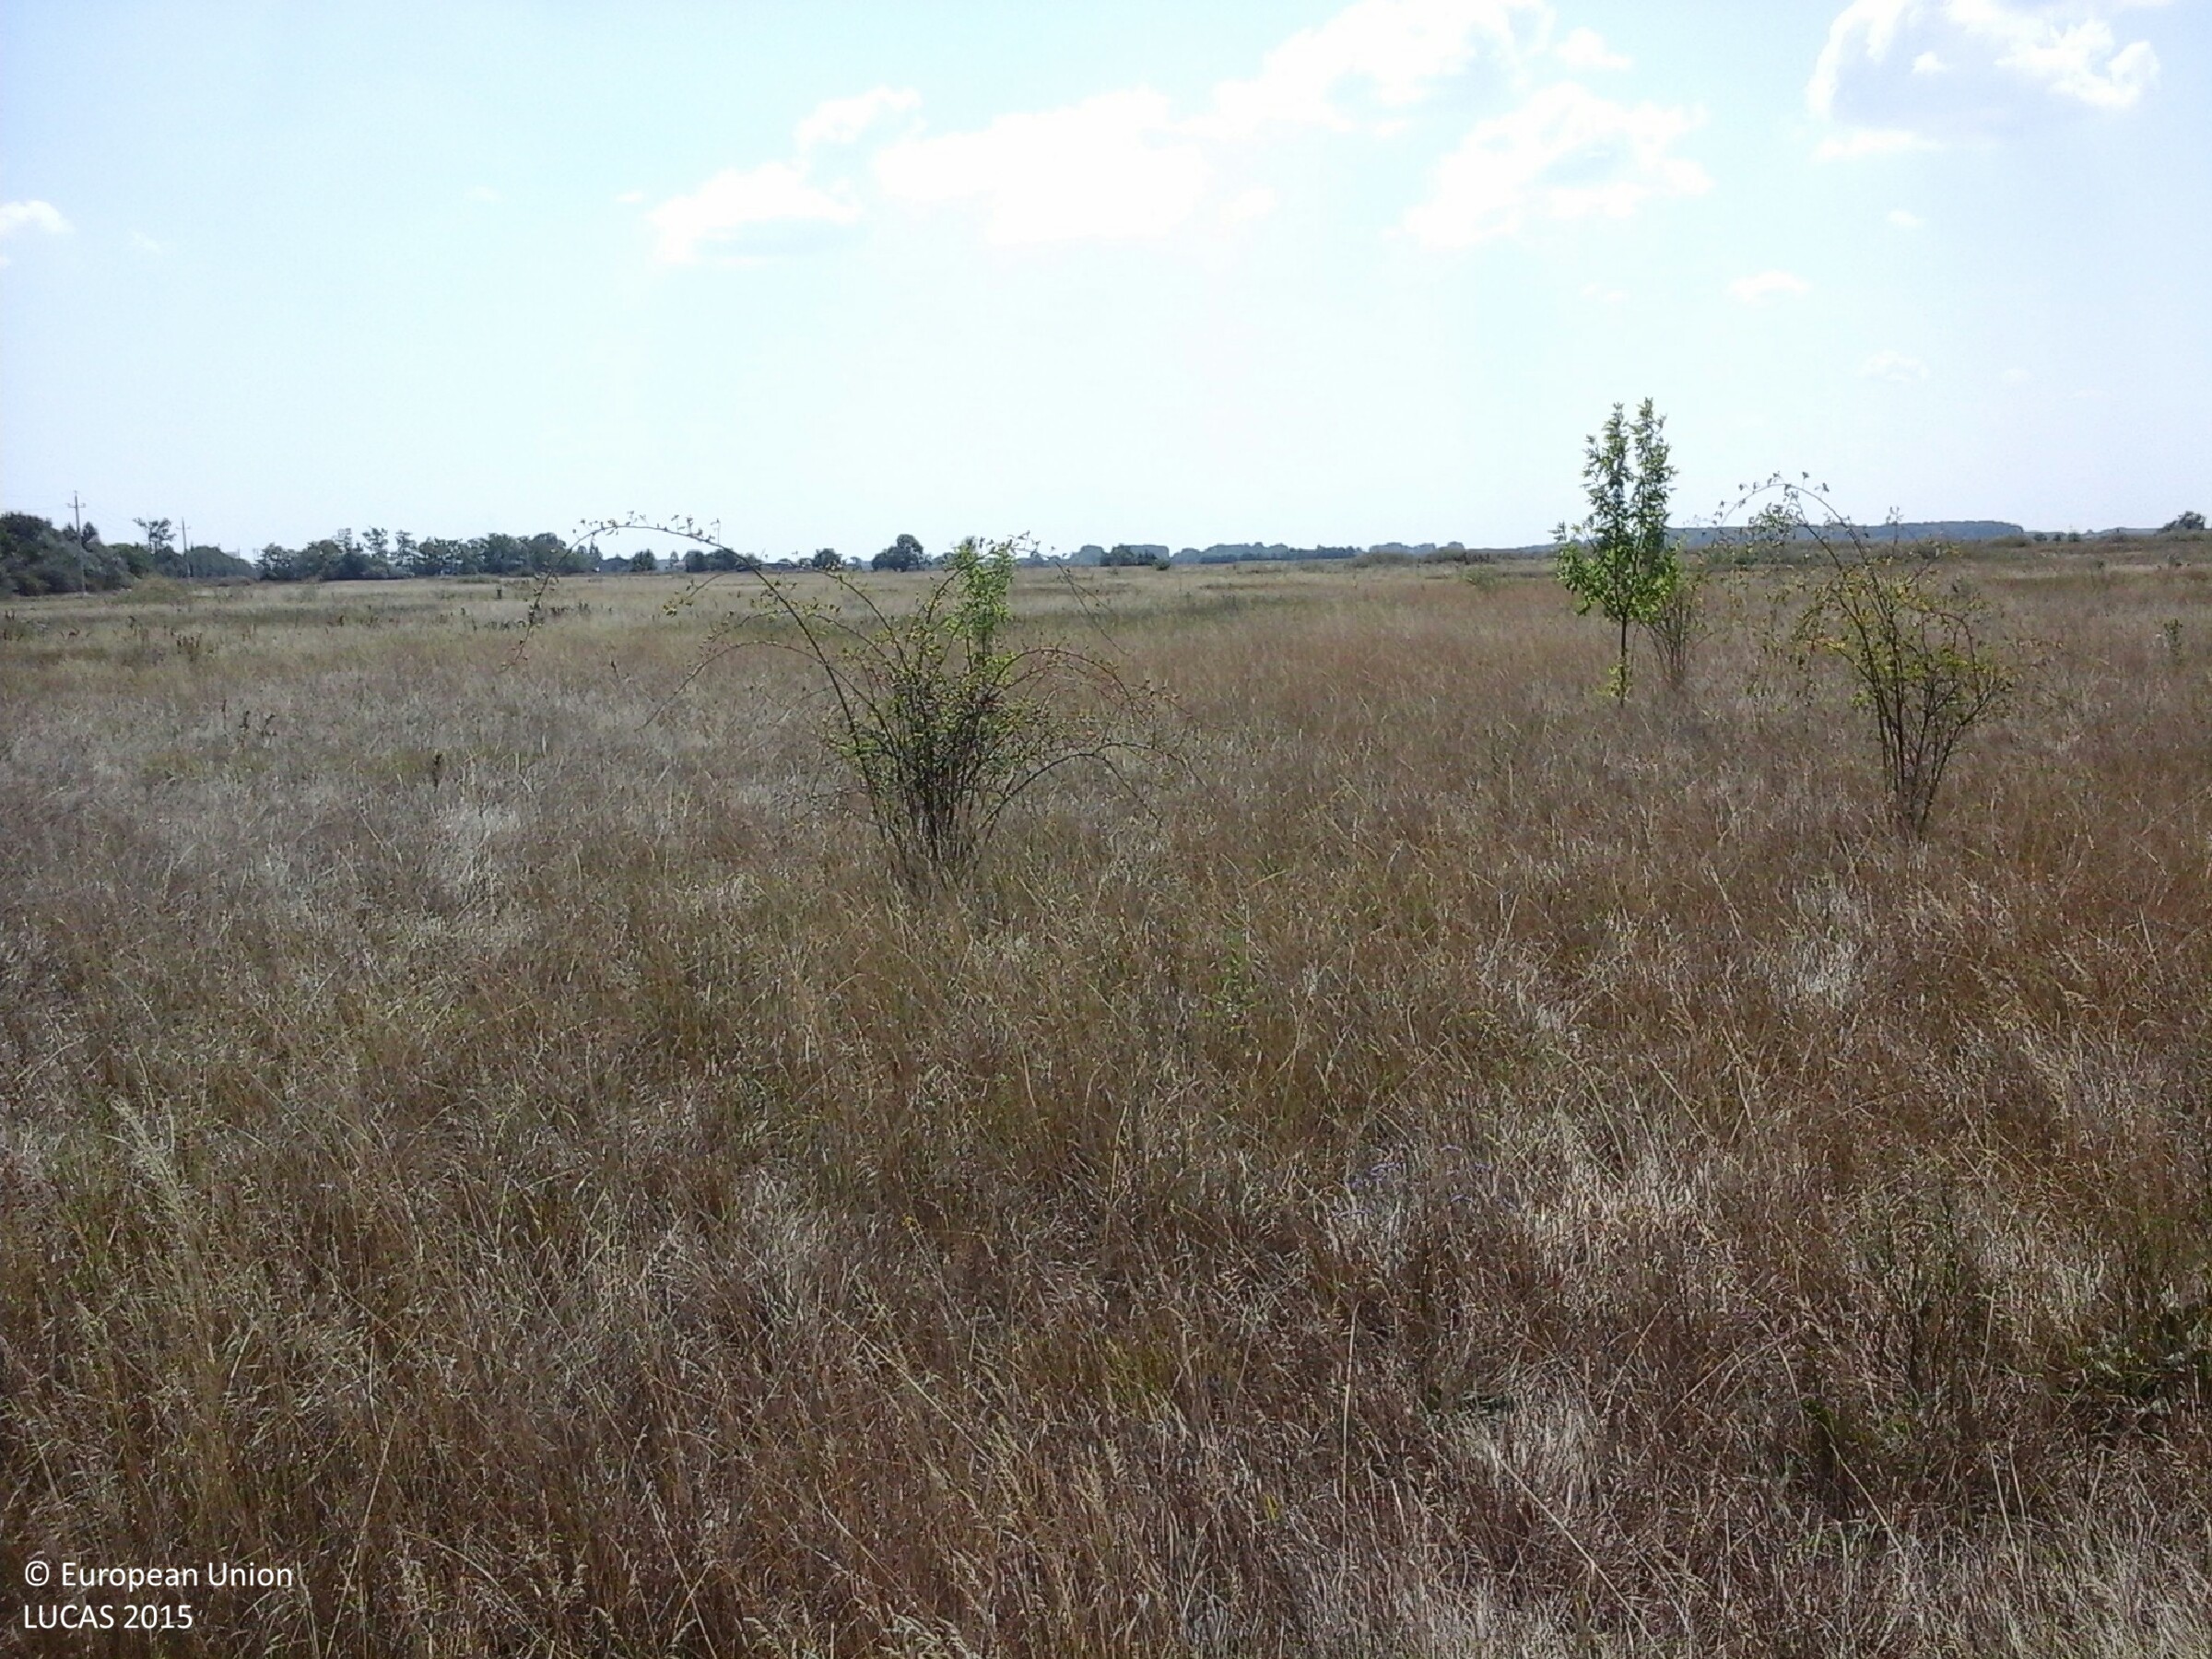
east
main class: Grassland
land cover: Grassland without tree/shrub cover
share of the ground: > 75 %
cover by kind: herbaceous plants 100 %
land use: Agriculture (excluding fallow land and kitchen gardens)
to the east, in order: Grassland without tree/shrub cover; Electric lines; Grassland without tree/shrub cover; Electric lines; Broadleaved woodland; Ditches and canals; Paved roads, cycling and walking lanes; Ditches and canals
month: July
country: HU
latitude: 47.6880
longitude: 20.4631
